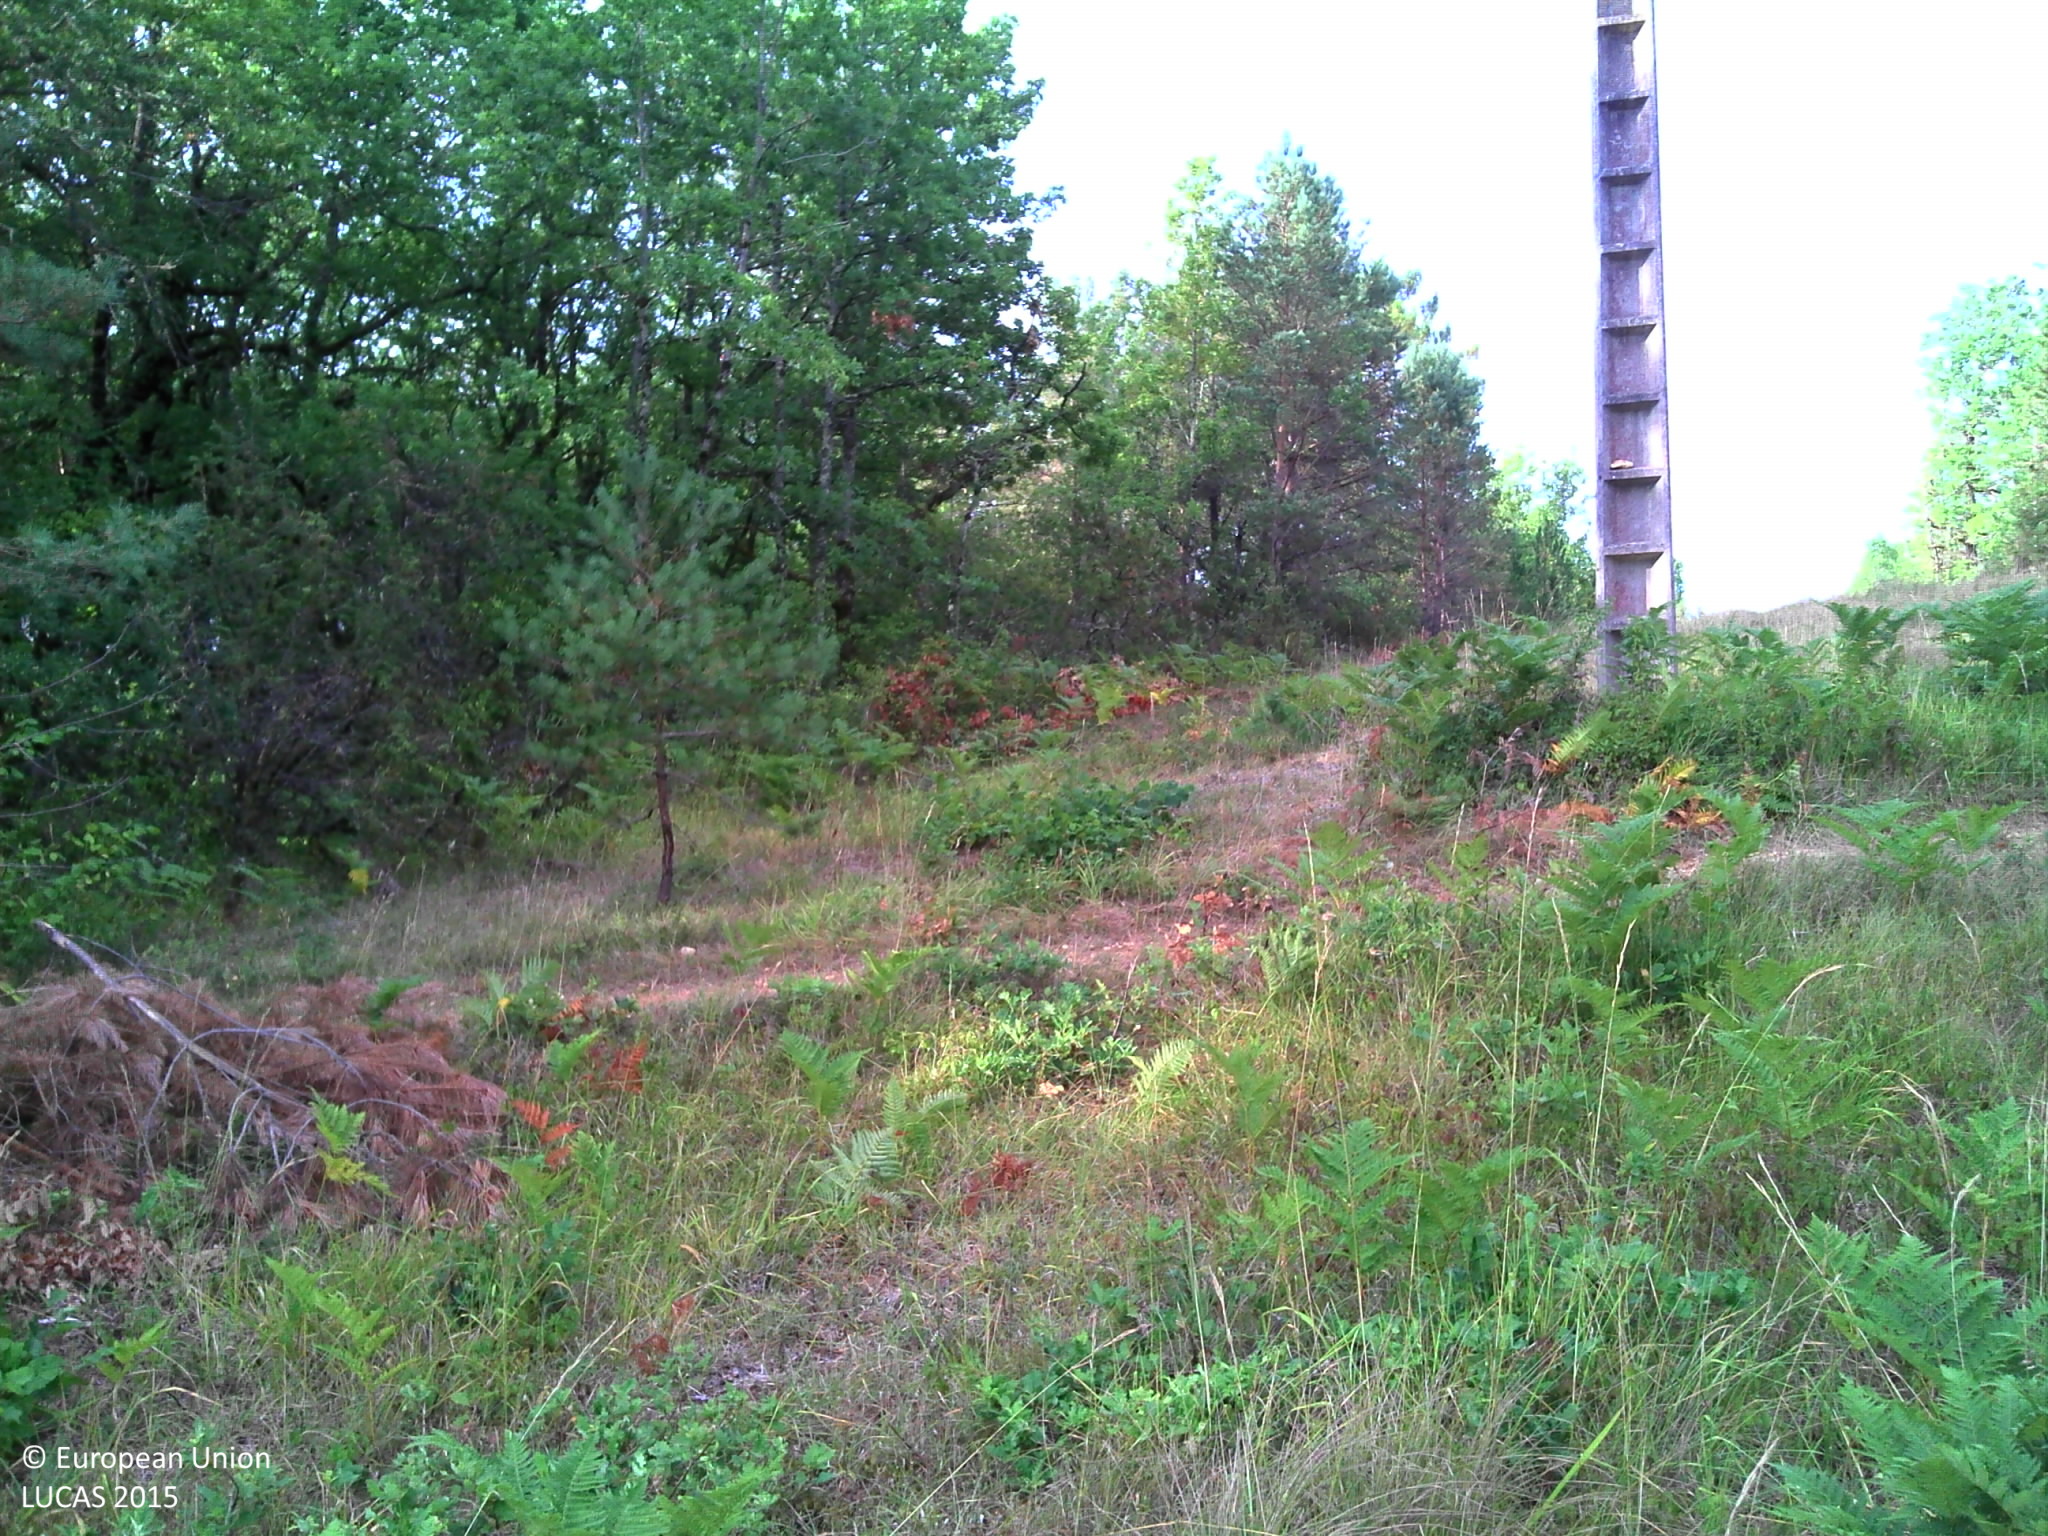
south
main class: Grassland
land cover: Spontaneously vegetated surfaces
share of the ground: > 75 %
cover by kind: herbaceous plants 90 %, shrubs 5 %, lichens and mosses 5 %
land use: Semi-natural and natural areas not in use
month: July
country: FR
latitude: 44.9213
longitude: 0.8074
